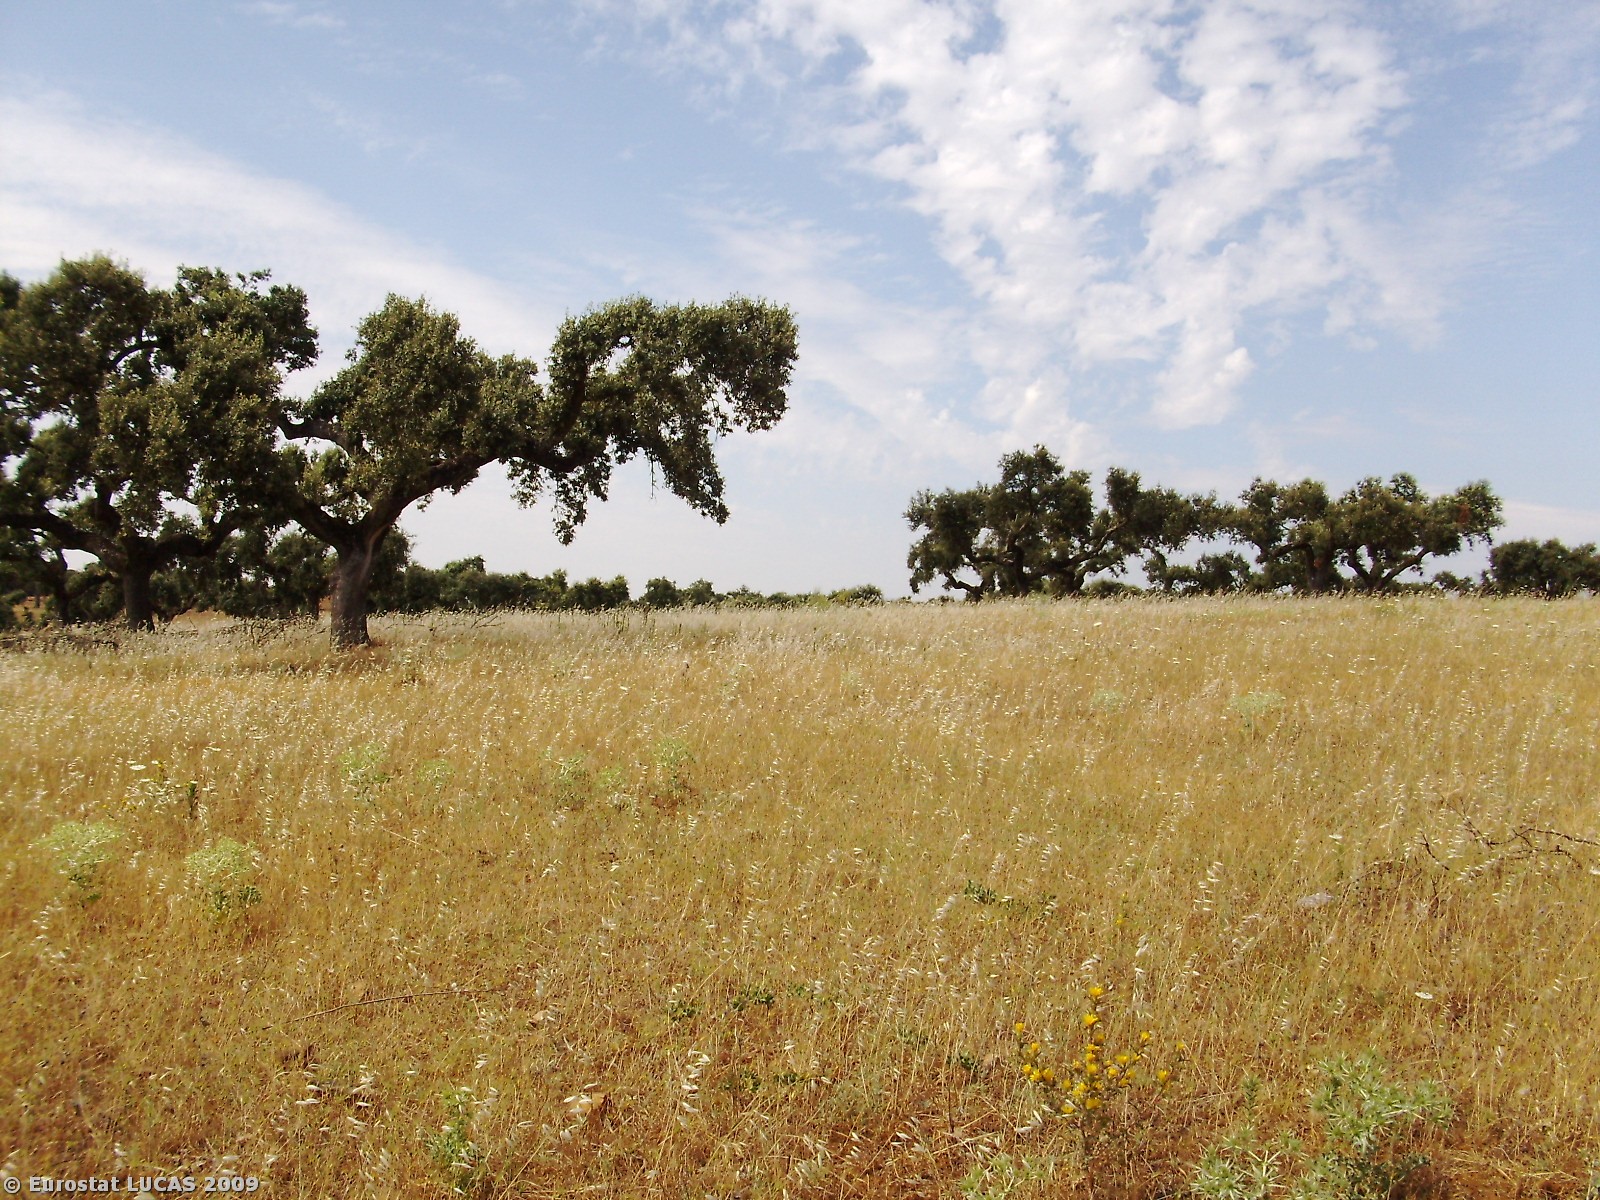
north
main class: Woodland
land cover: Broadleaved woodland
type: broadleaved evergreen forest
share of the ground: 10 - 25 %
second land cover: Spontaneously vegetated surfaces
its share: 50 - 75 %
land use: Forestry
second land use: Fallow land
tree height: > 5 m
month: June
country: PT
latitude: 39.1101
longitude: -7.3722
